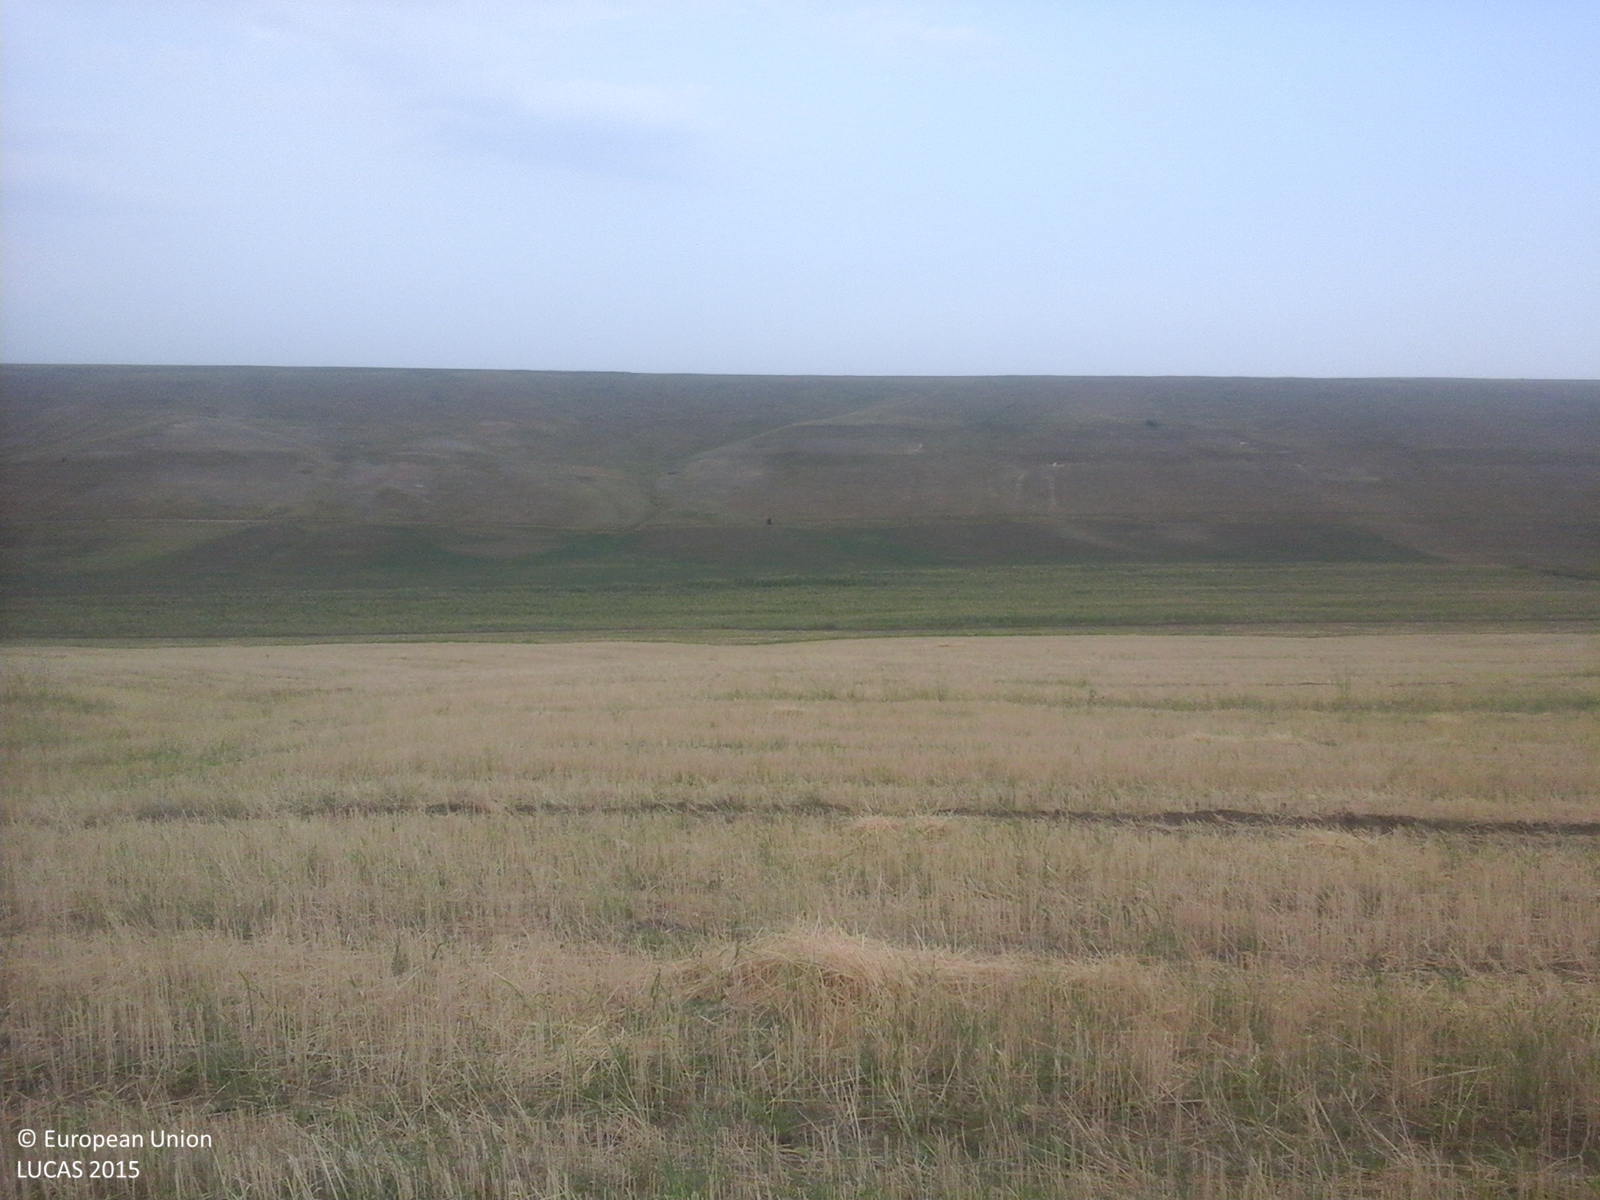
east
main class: Cropland
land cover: Common wheat
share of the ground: 50 - 75 %
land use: Agriculture (excluding fallow land and kitchen gardens)
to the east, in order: Common wheat; Grass margins; Other leguminous and mixtures for fodder; Grass margins; Tracks; Shruby margins; Sunflower; Maize
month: July
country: RO
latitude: 45.8438
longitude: 27.9795
